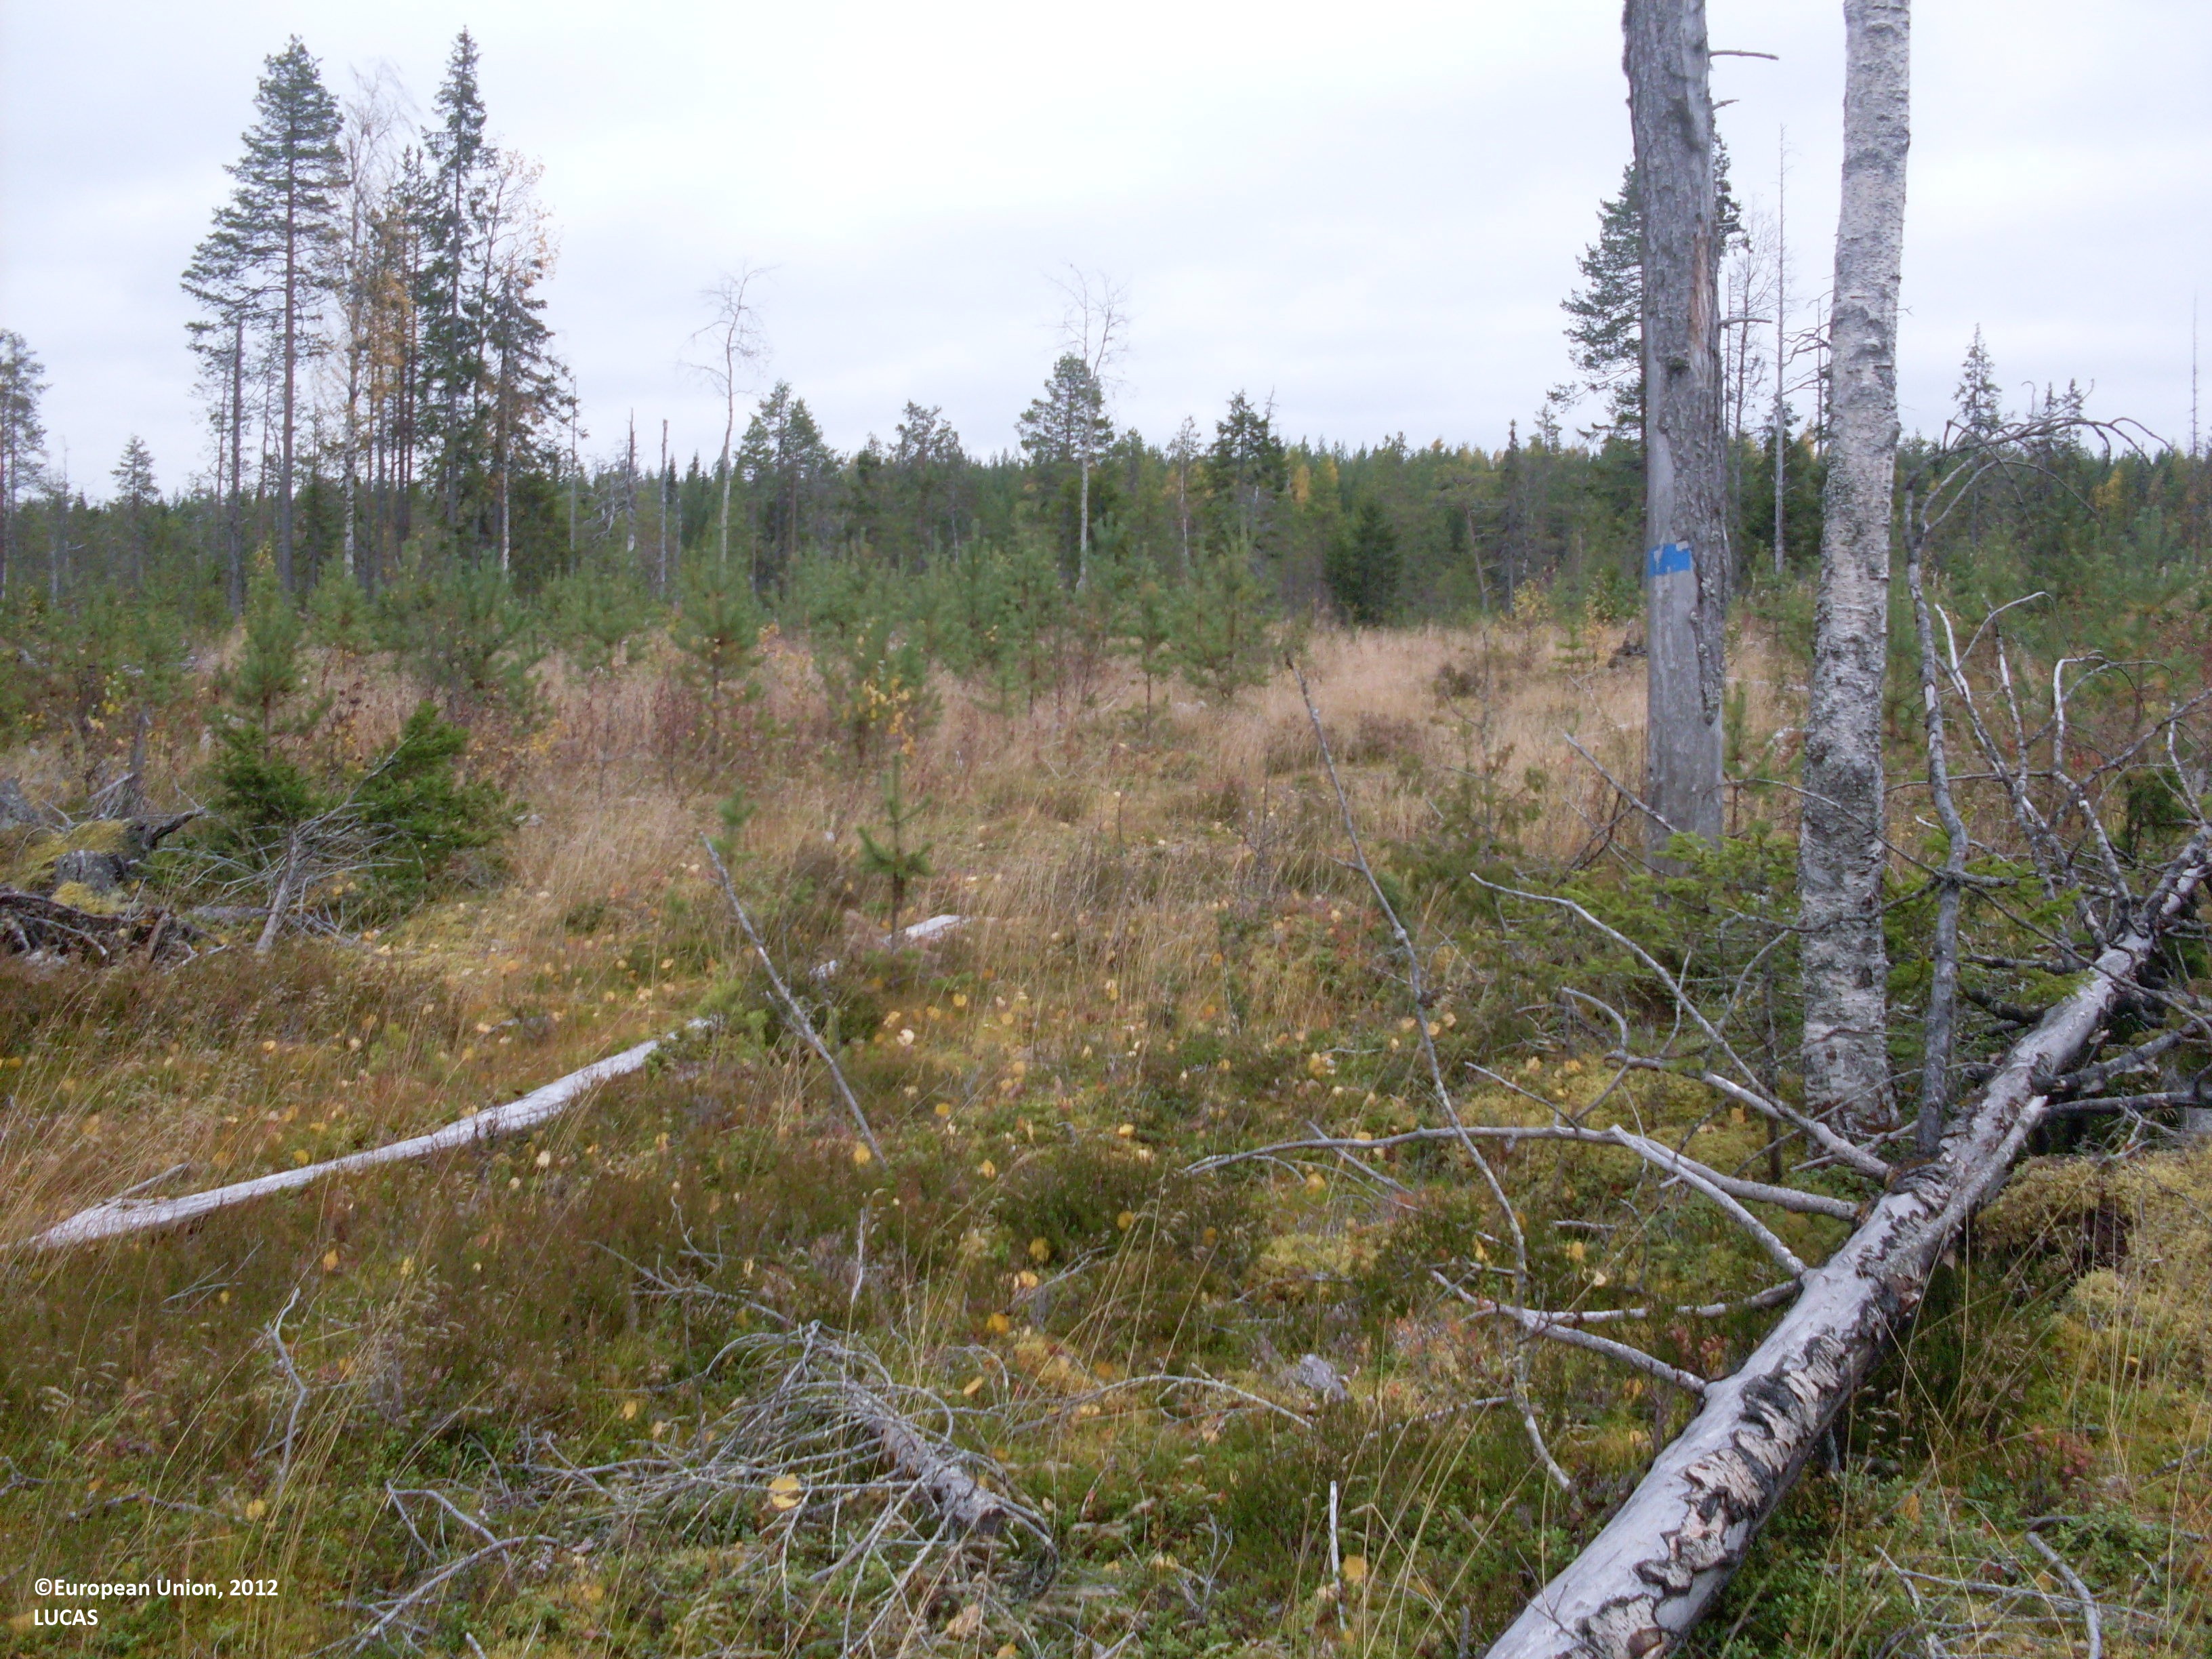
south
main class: Shrubland
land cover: Shrubland with sparse tree cover
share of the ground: 50 - 75 %
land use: Forestry
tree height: > 5 m
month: September
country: FI
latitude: 64.4147
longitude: 30.0141
